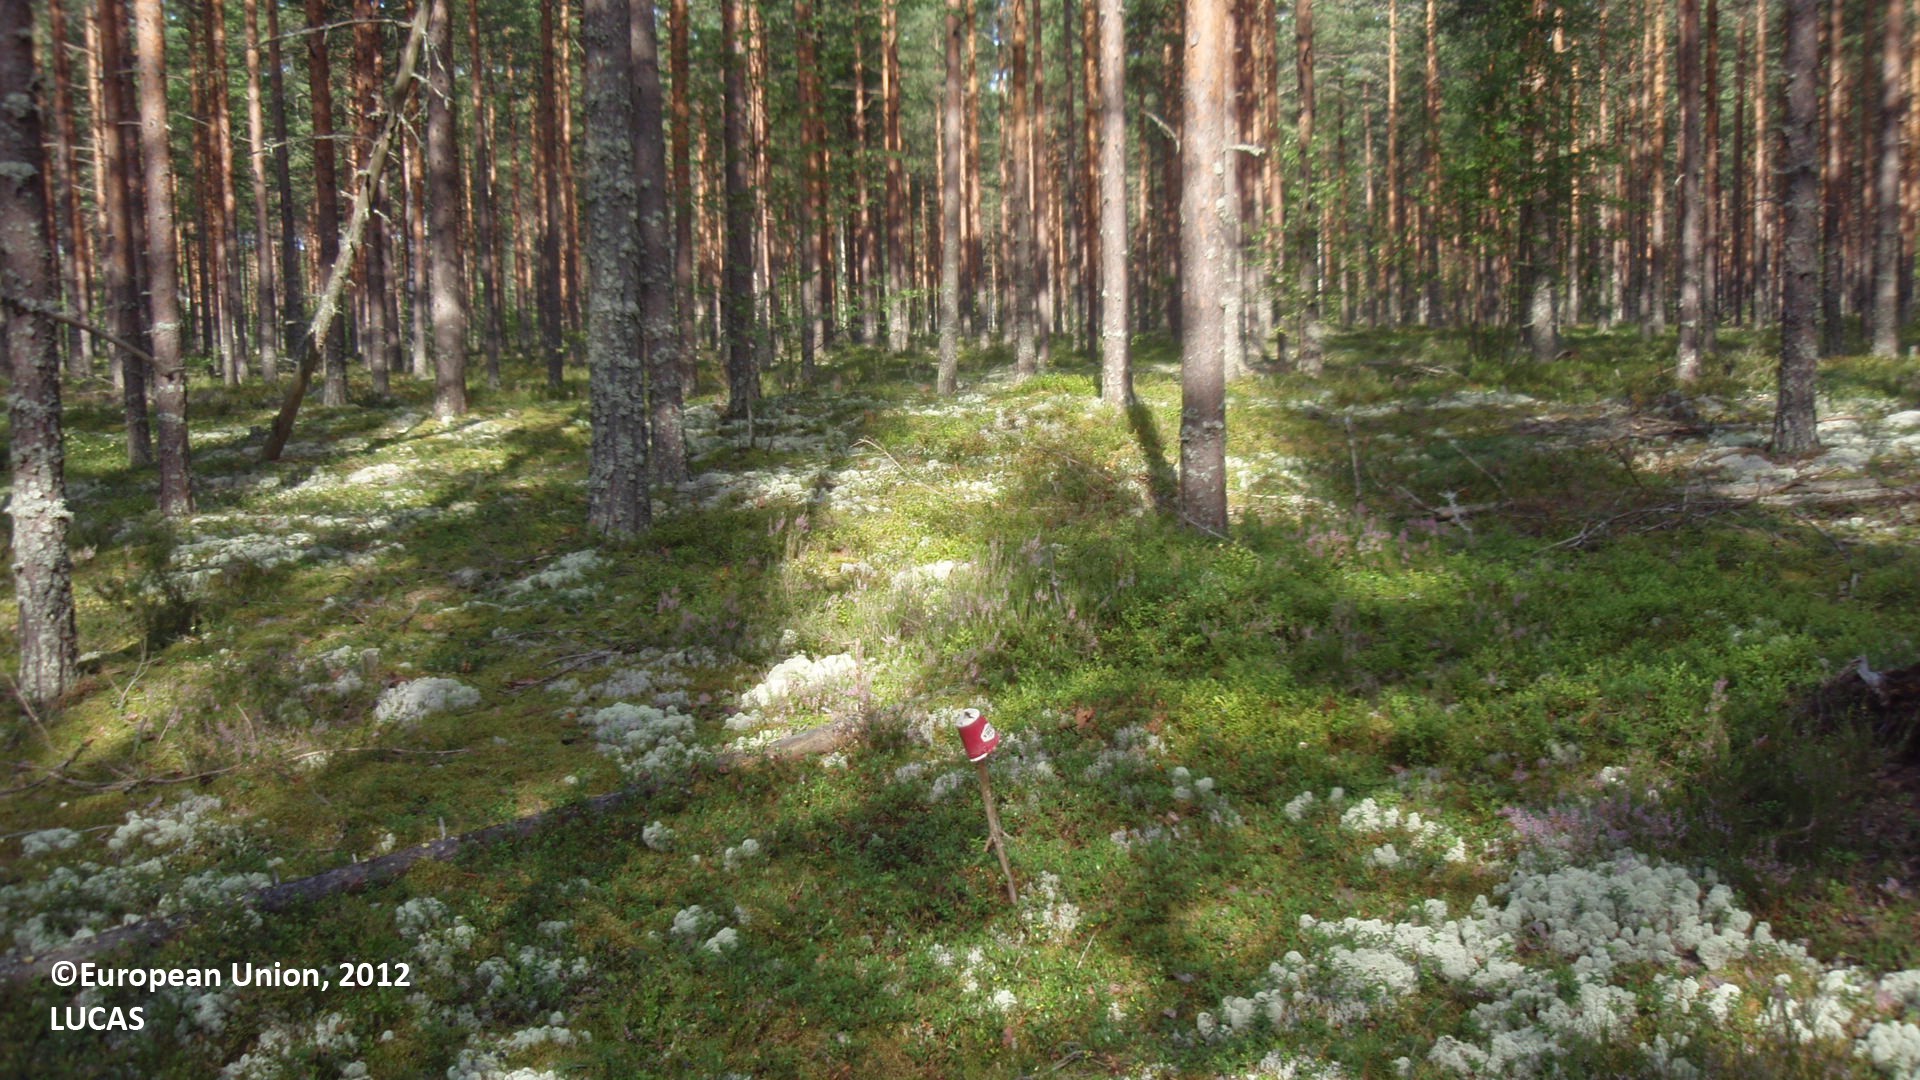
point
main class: Woodland
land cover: Pine dominated coniferous woodland
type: boreal forest
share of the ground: 50 - 75 %
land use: Forestry
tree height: > 5 m
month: August
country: FI
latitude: 61.2654
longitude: 28.0427
